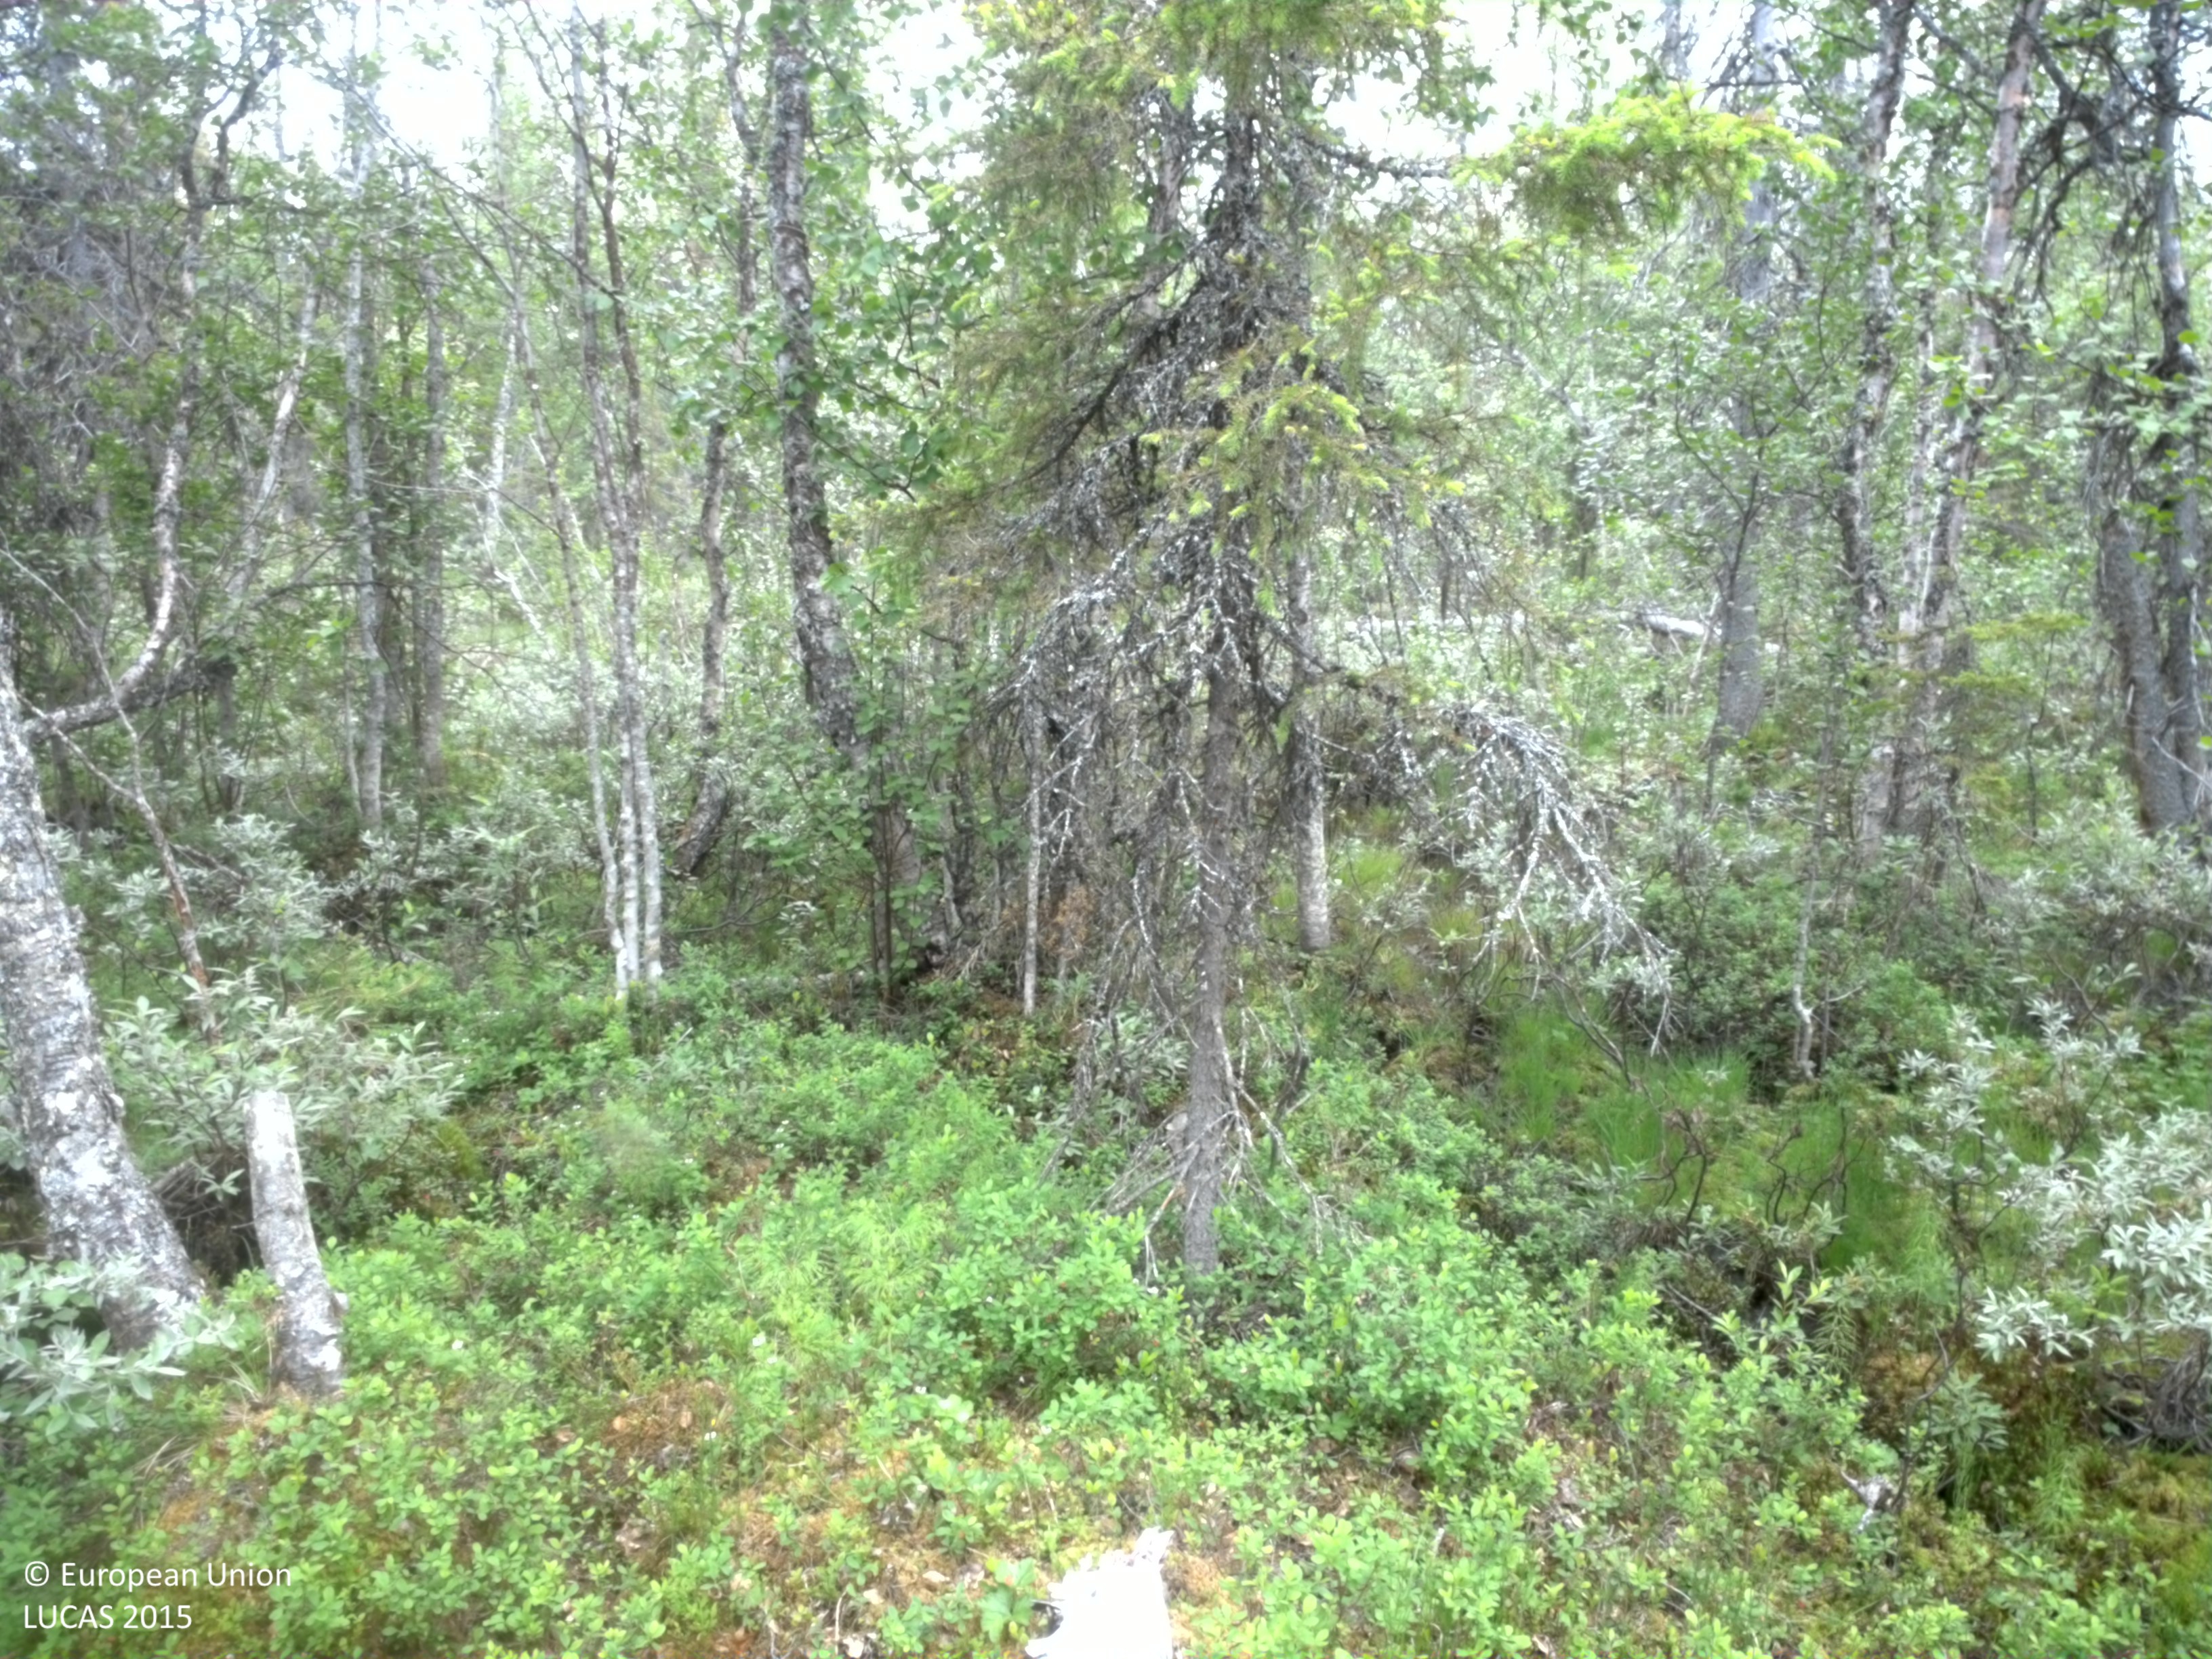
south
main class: Woodland
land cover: Spruce dominated mixed woodland
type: mire and swamp forests
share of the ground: 50 - 75 %
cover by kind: shrubs 40 %, coniferous forest trees 35 %, broadleaved forest trees 20 %, lichens and mosses 5 %
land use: Forestry
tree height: > 5 m
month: July
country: SE
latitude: 67.2688
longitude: 19.1506
